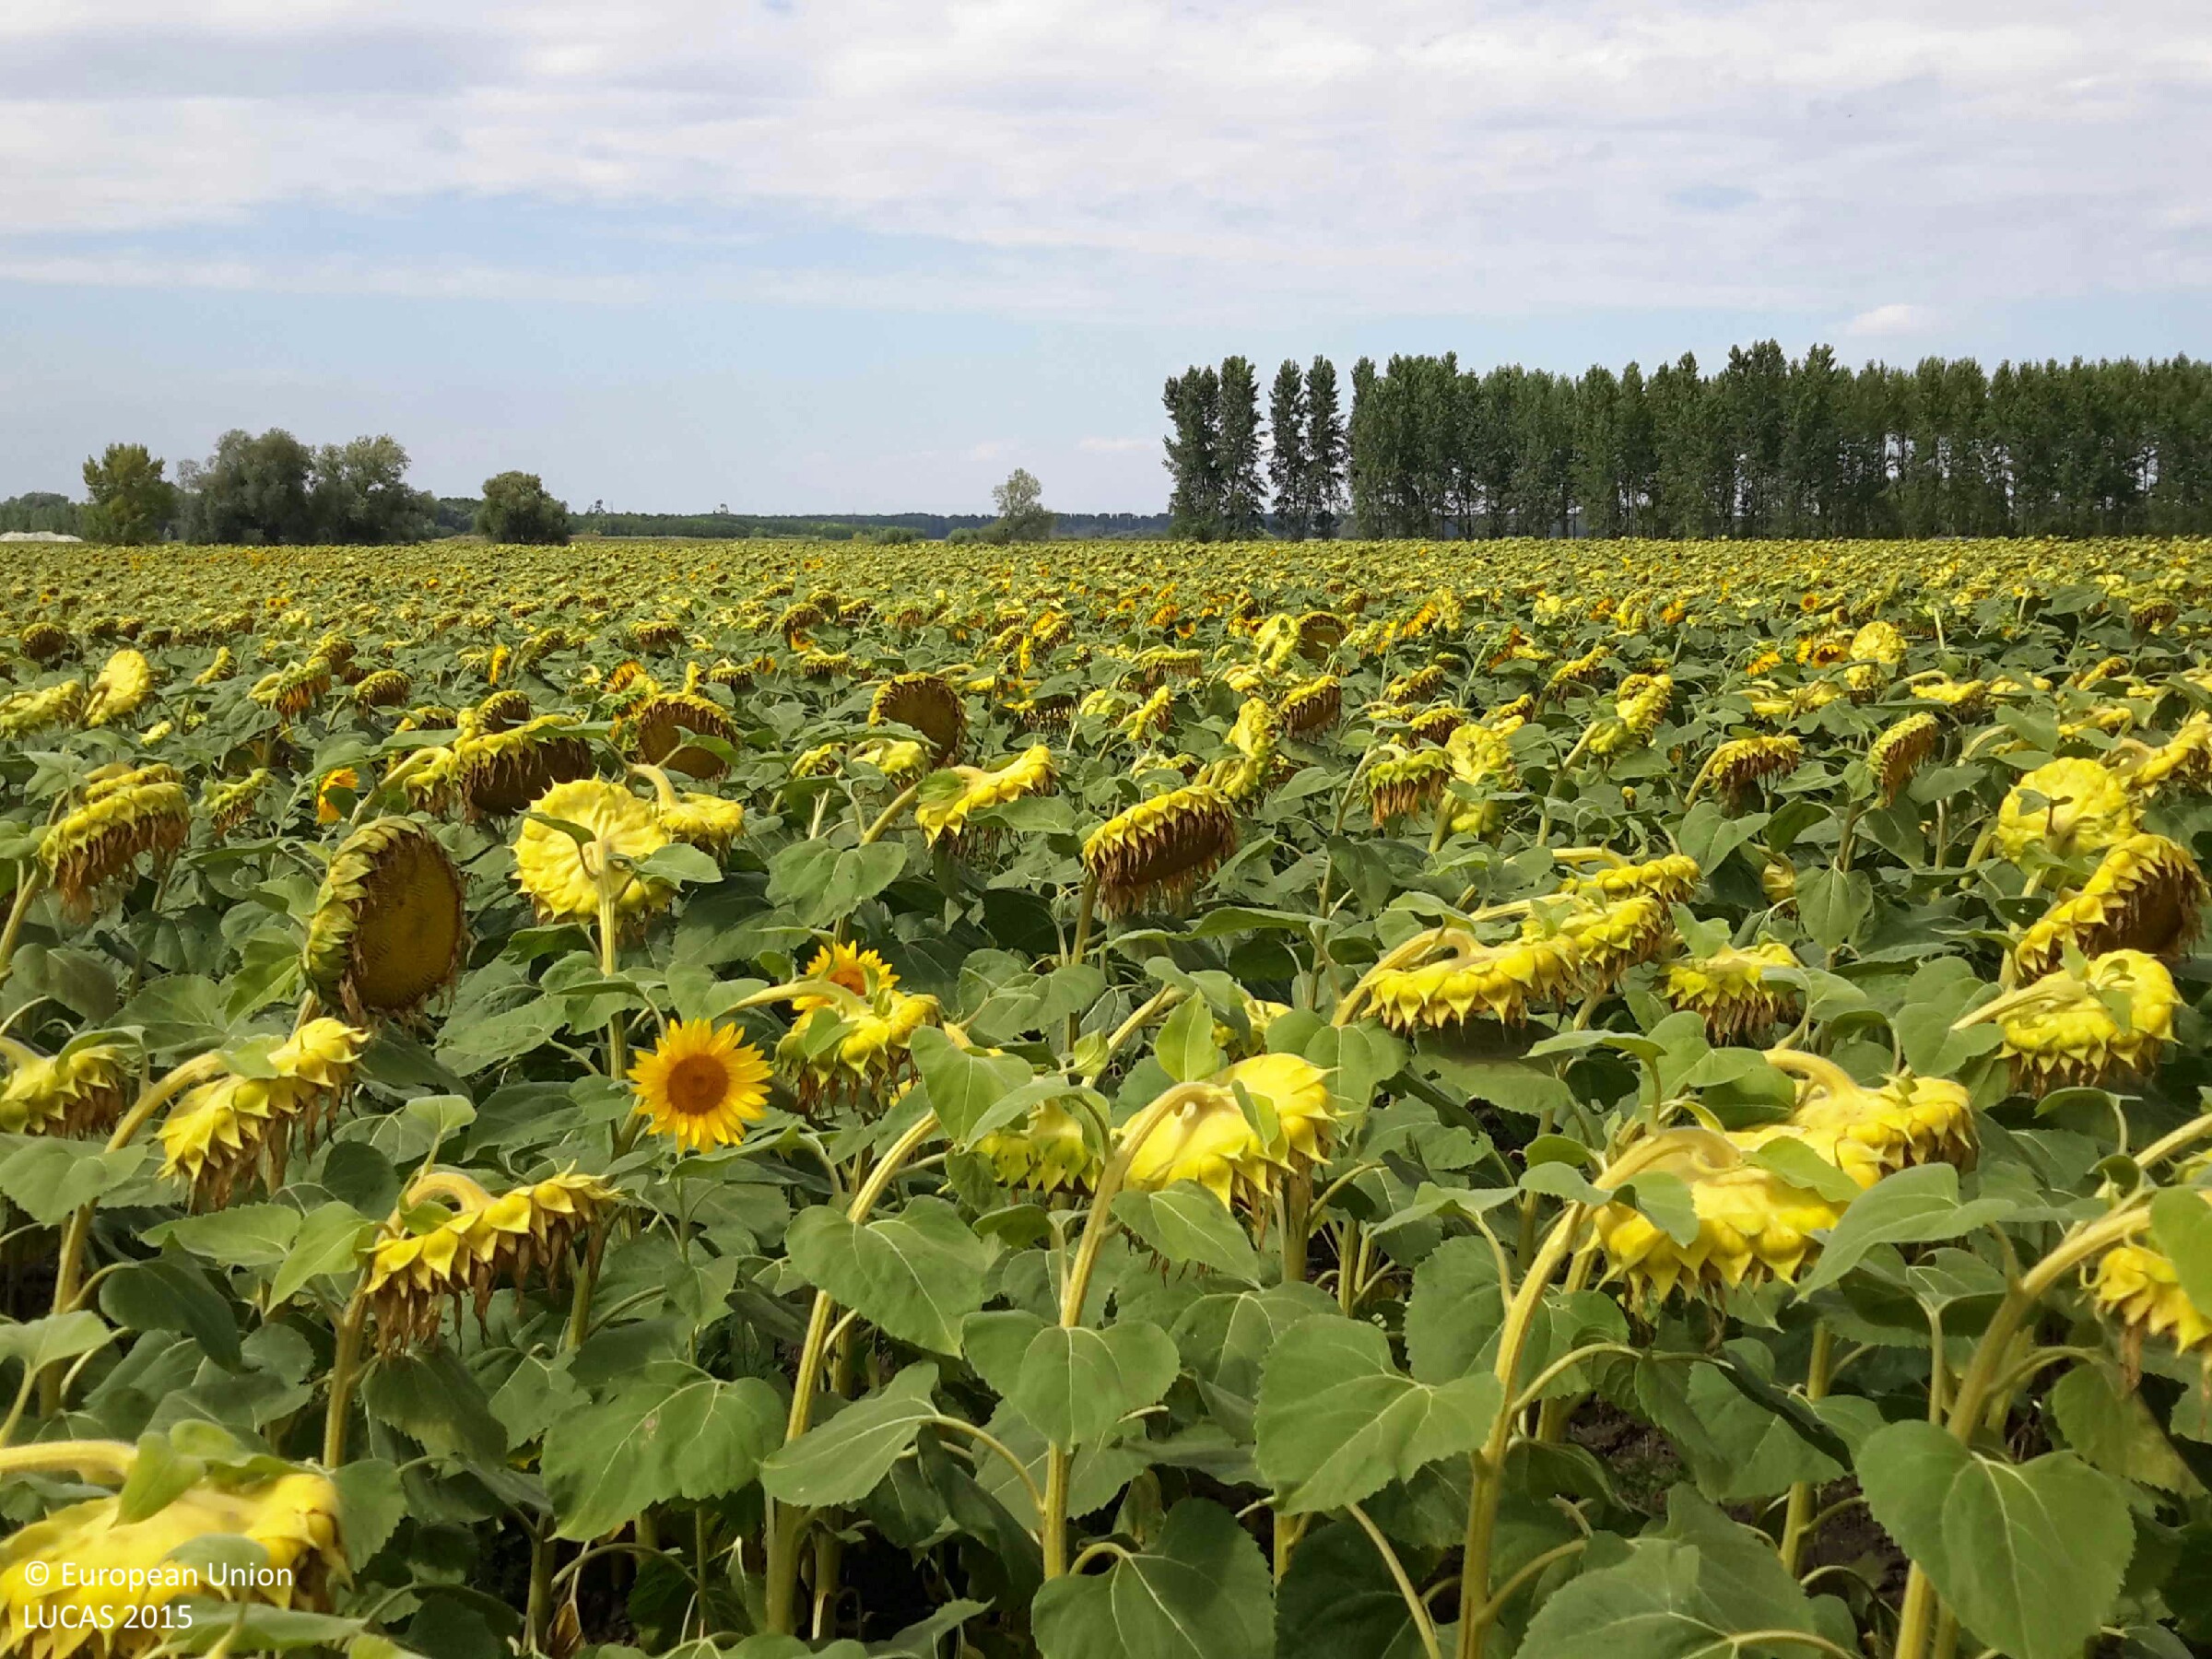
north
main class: Cropland
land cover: Sunflower
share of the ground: > 75 %
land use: Agriculture (excluding fallow land and kitchen gardens)
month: July
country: HU
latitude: 47.5887
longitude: 17.4948
